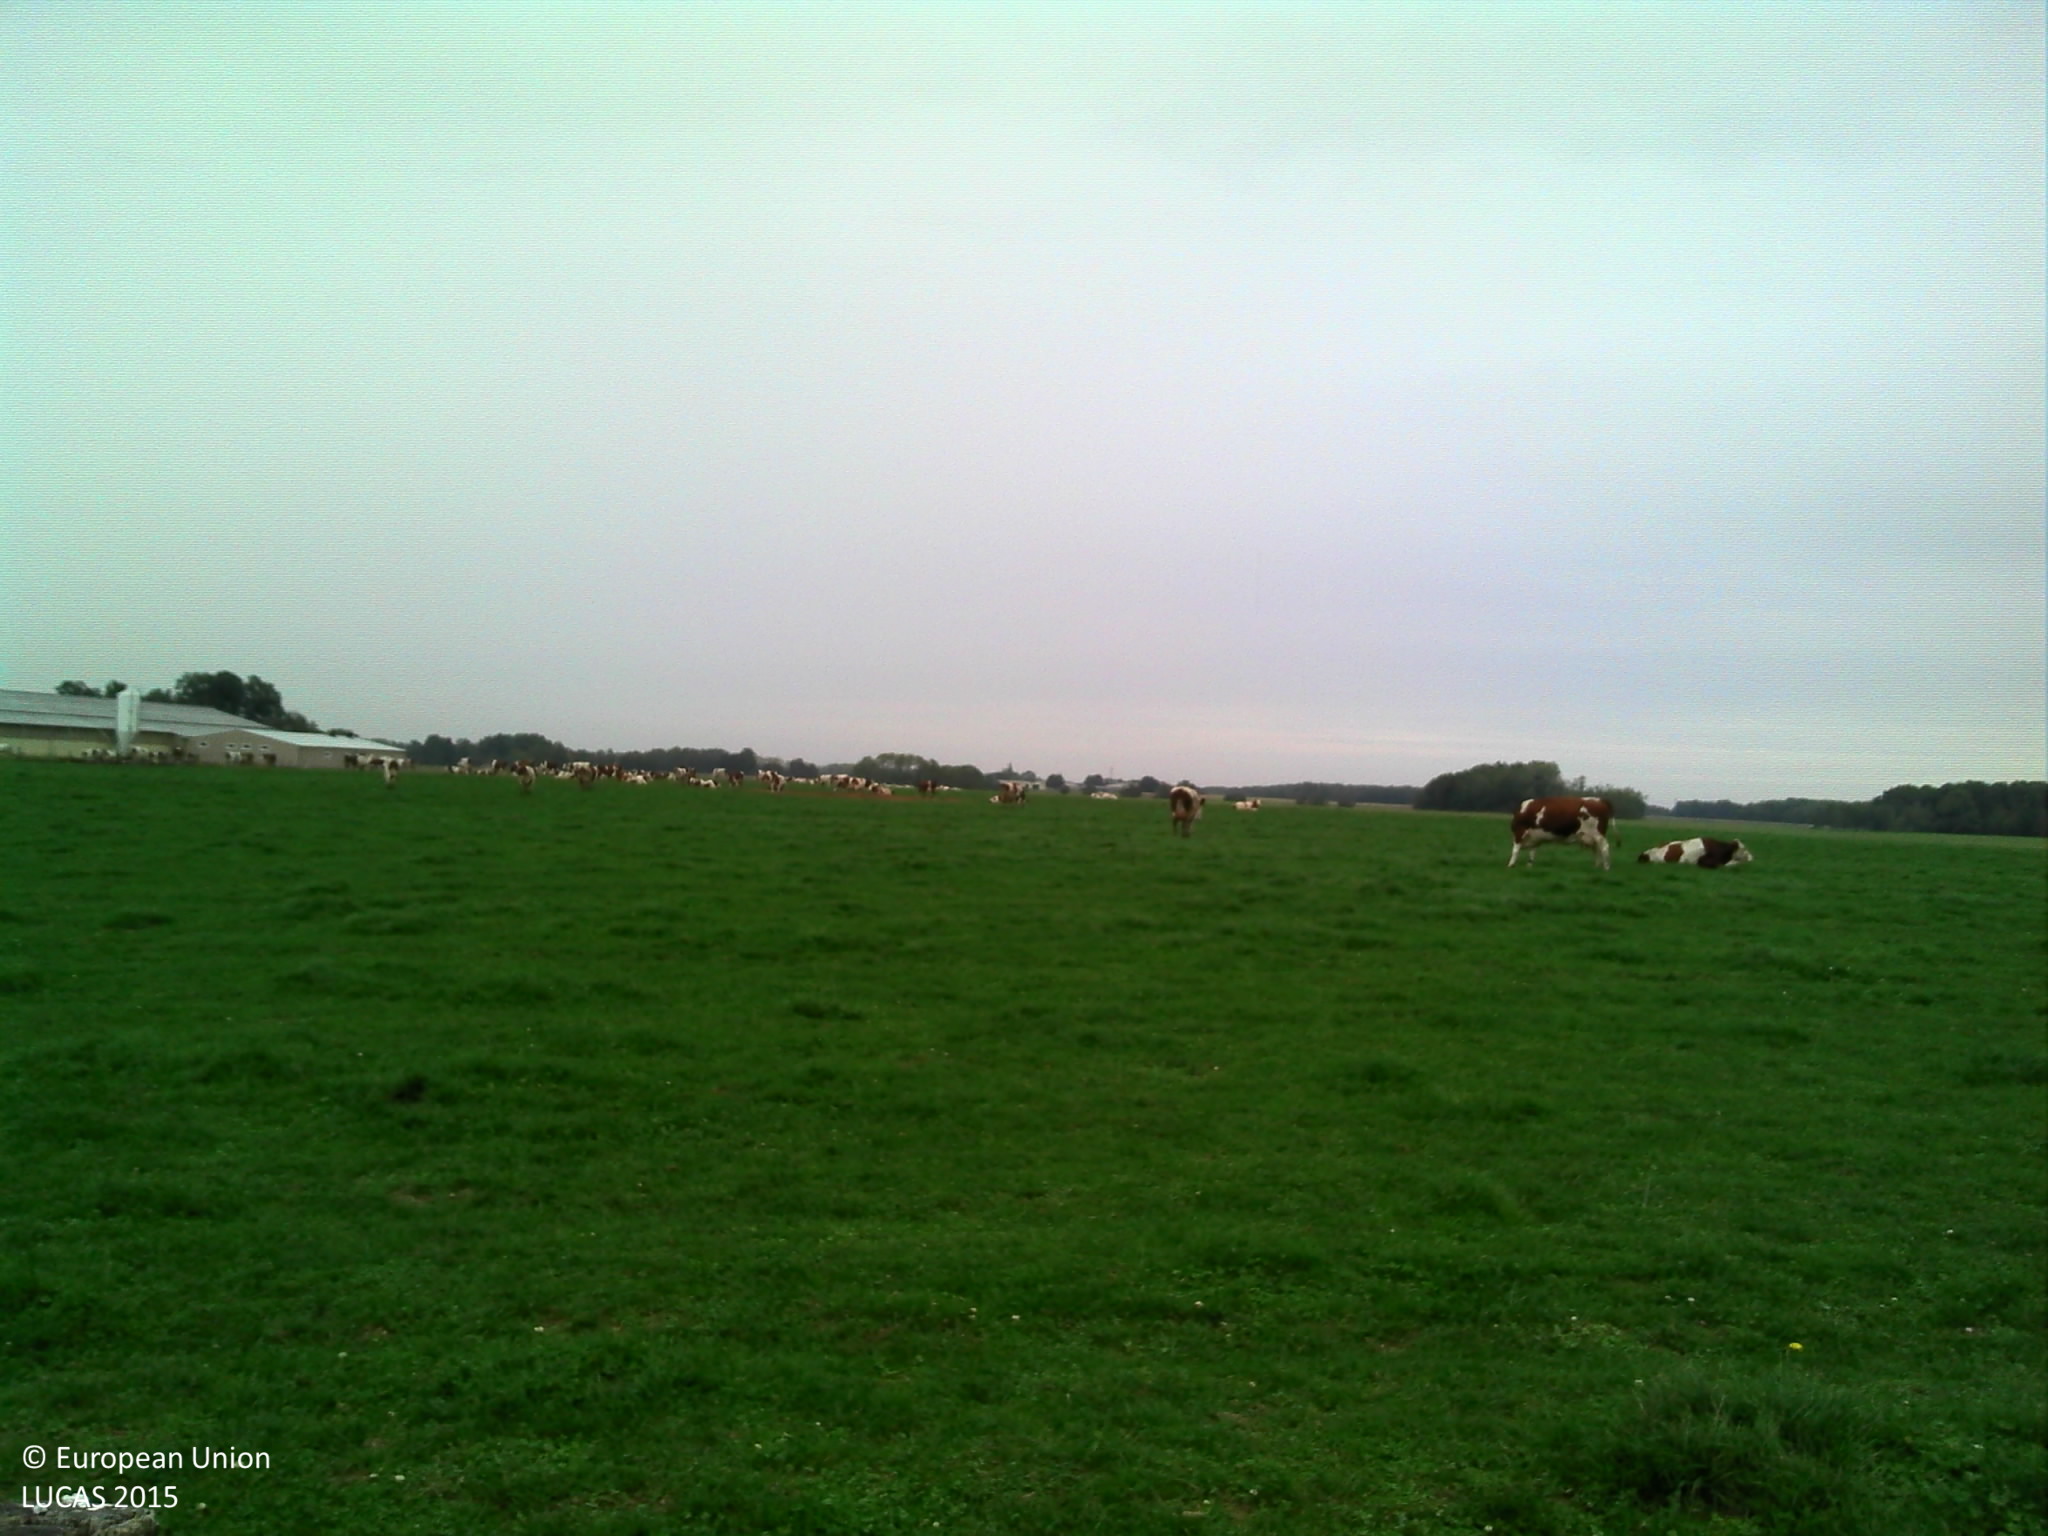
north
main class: Cropland
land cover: Temporary grasslands
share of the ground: > 75 %
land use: Agriculture (excluding fallow land and kitchen gardens)
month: October
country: FR
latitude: 46.4863
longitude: 4.9867
